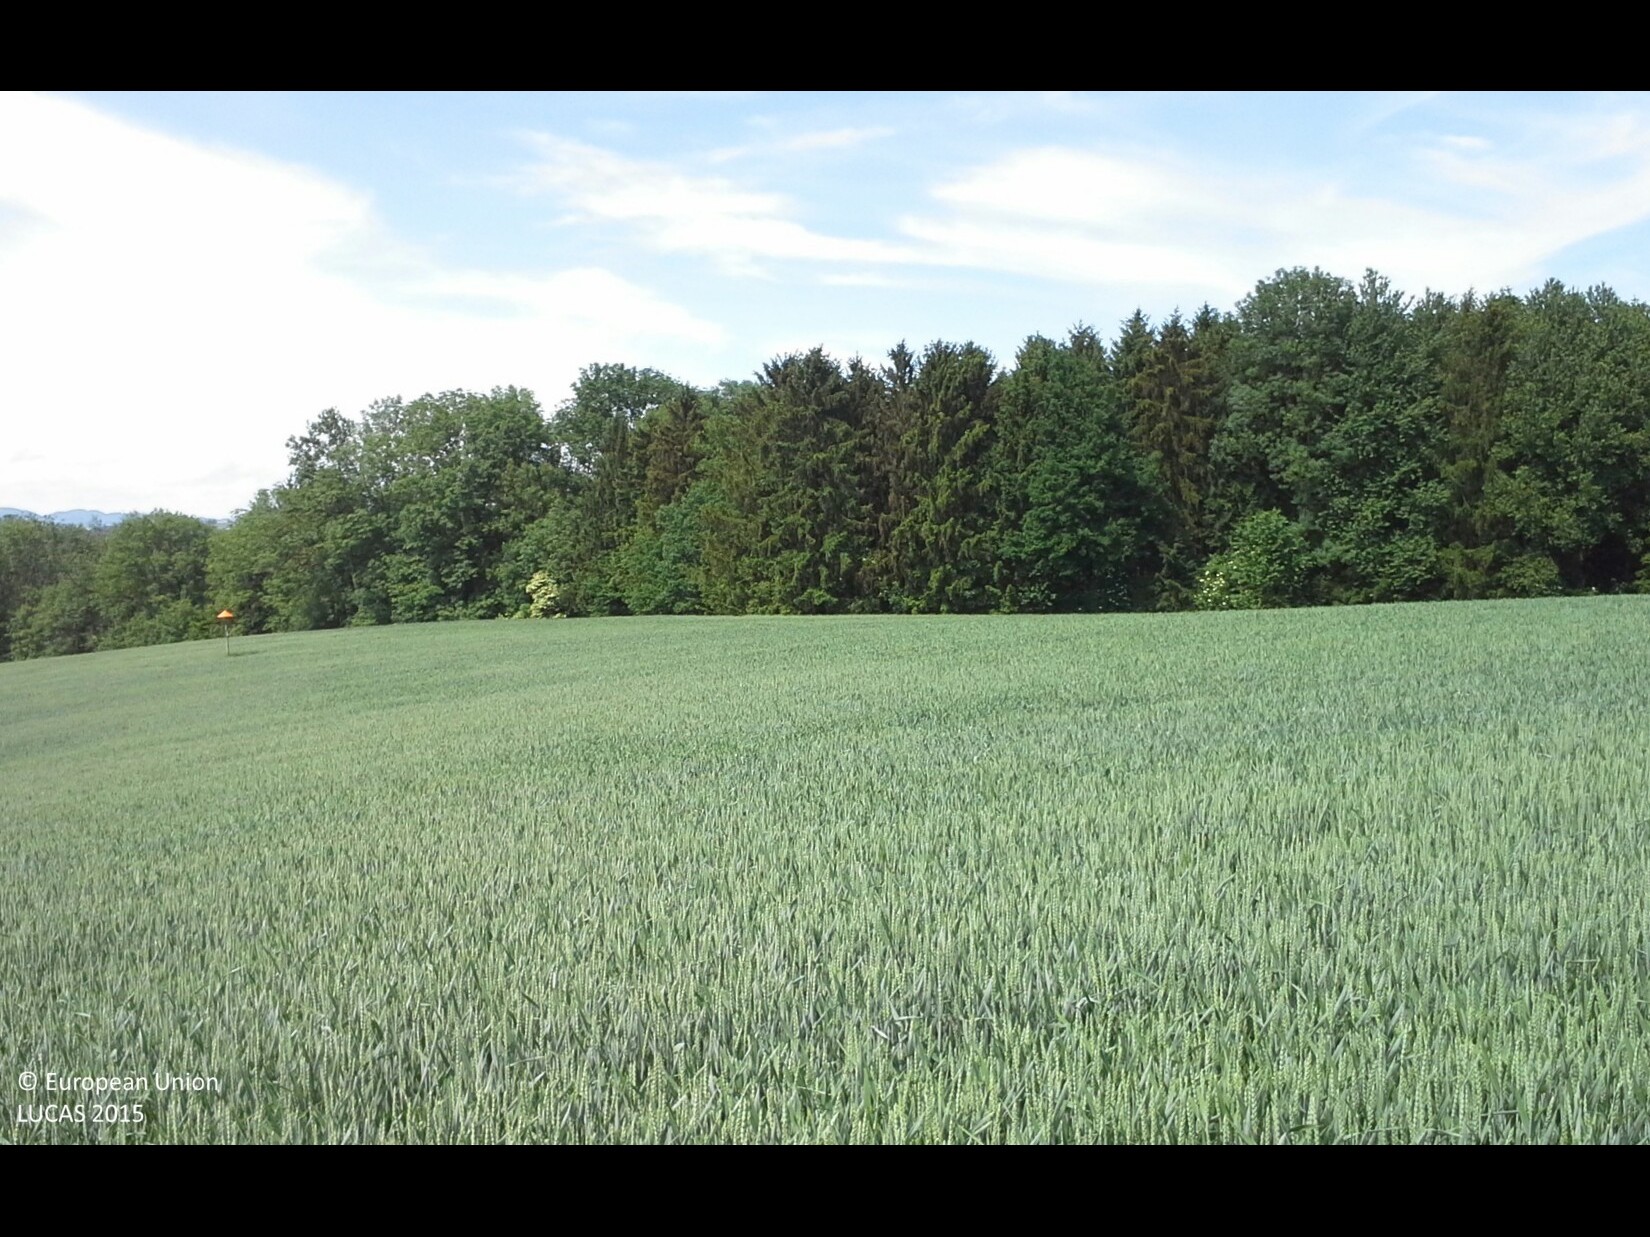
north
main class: Cropland
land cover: Common wheat
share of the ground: > 75 %
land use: Agriculture (excluding fallow land and kitchen gardens)
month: June
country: AT
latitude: 48.1539
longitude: 14.8266
